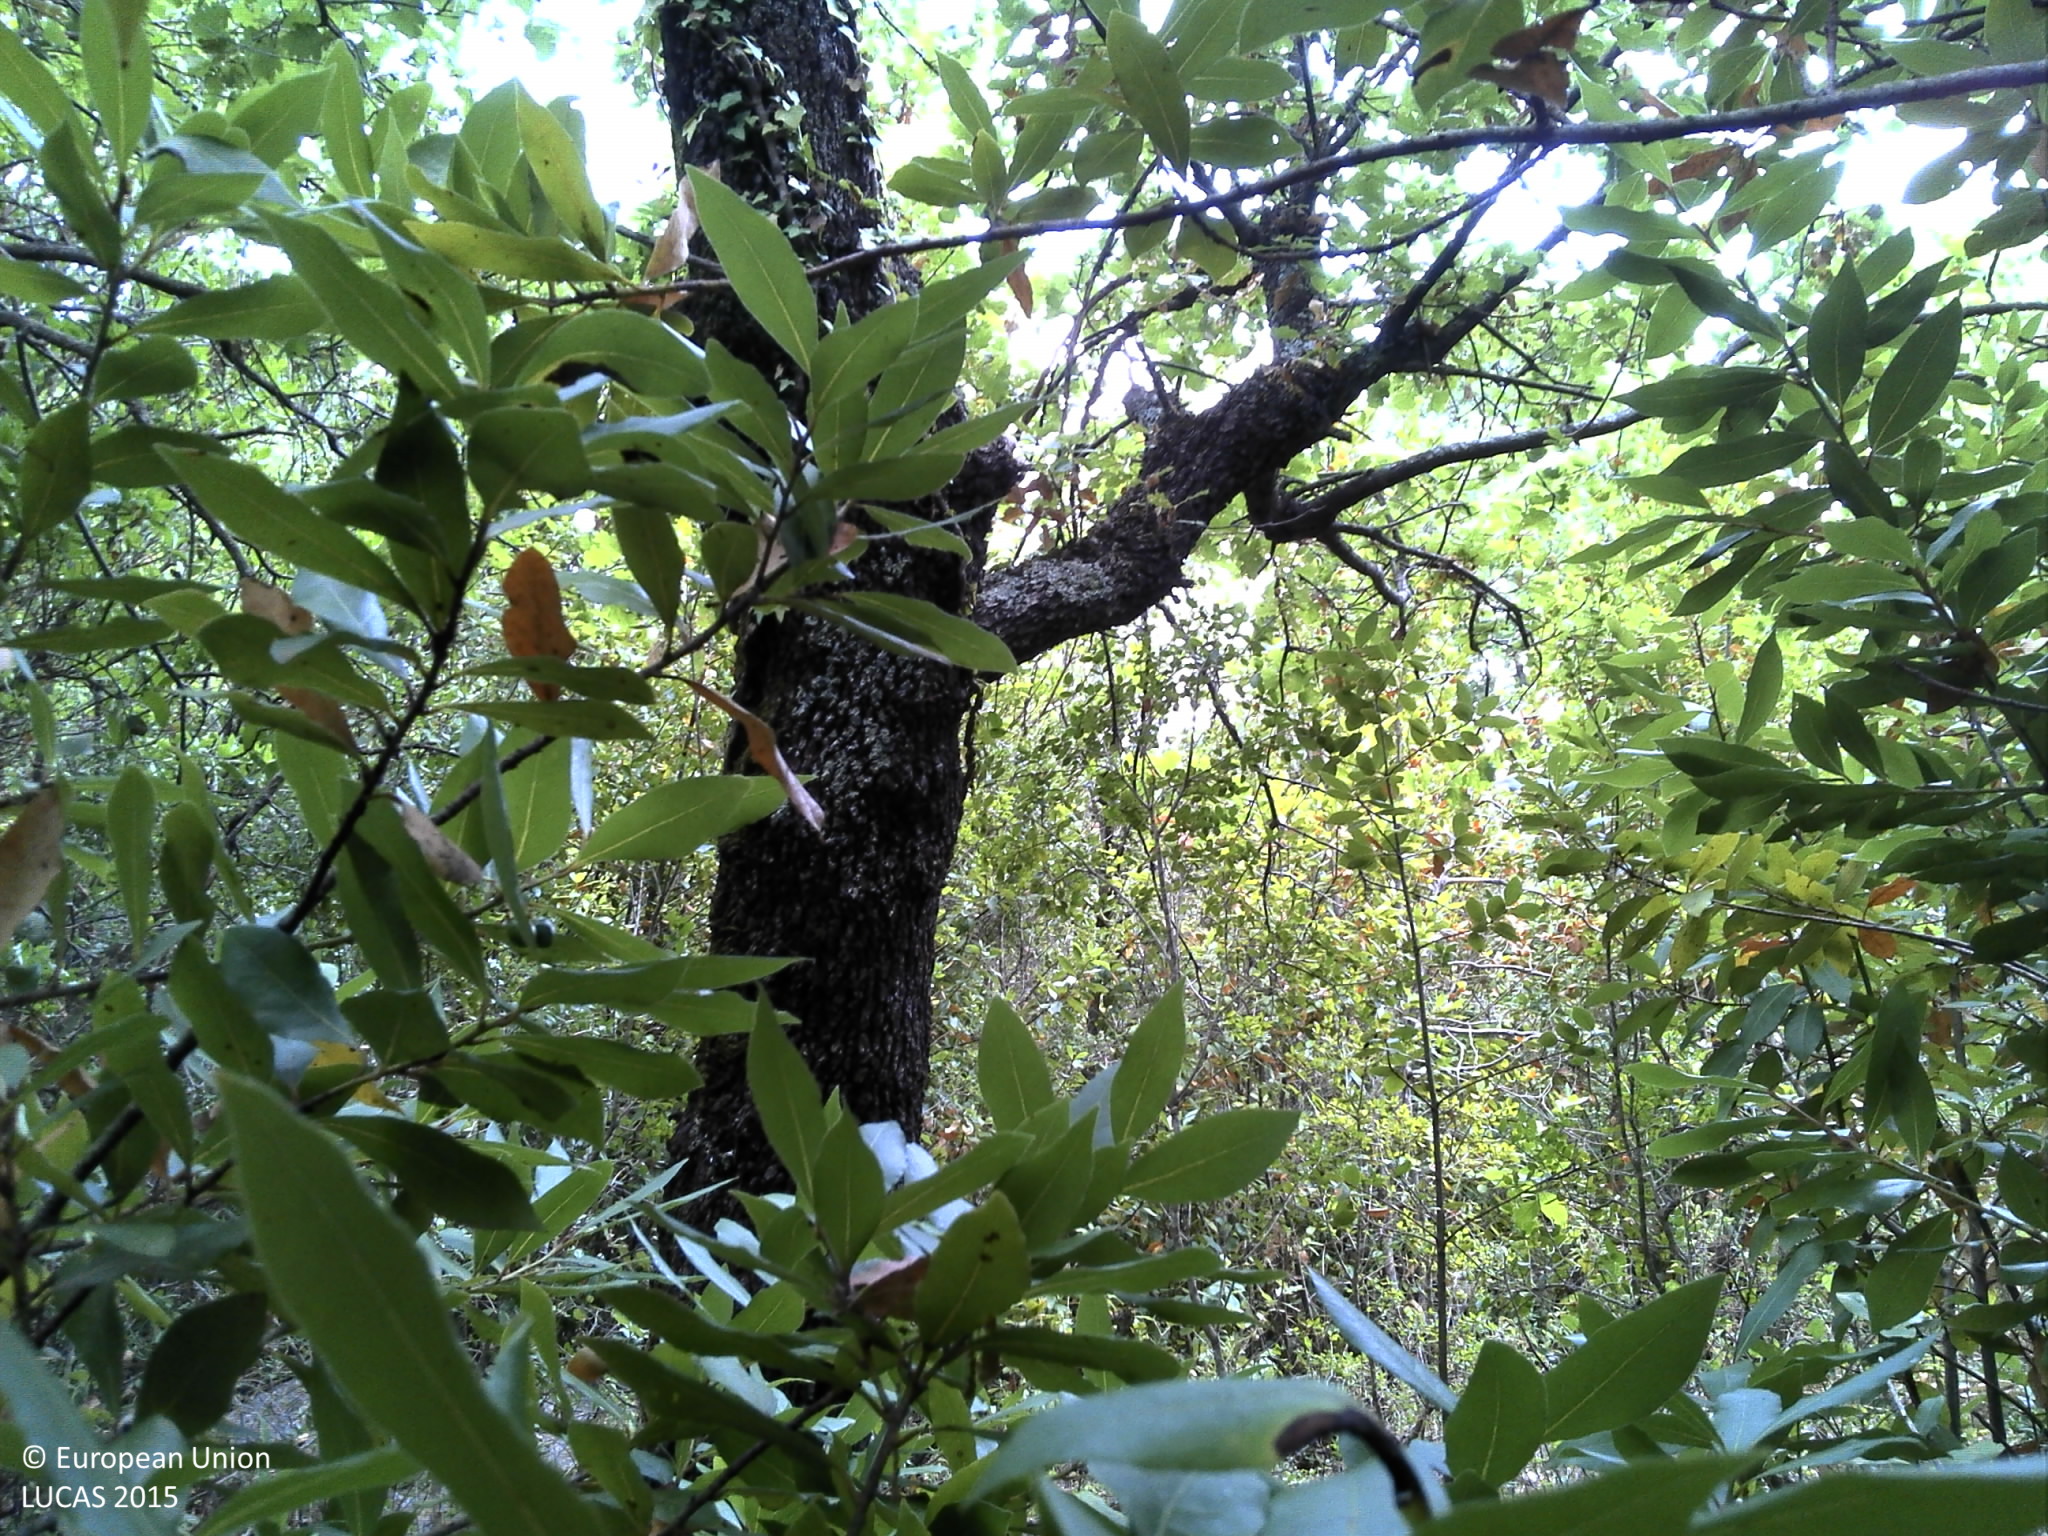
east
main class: Woodland
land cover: Other mixed woodland
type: coniferous forest of the mediterranean region
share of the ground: 25 - 50 %
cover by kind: coniferous forest trees 30 %, herbaceous plants 30 %, broadleaved forest trees 20 %, shrubs 10 %, unconsolidated bare surface 10 %
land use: Semi-natural and natural areas not in use
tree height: > 5 m
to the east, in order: Other mixed woodland; Grassland with sparse tree/shrub cover; Dry stone walls; Vineyards; Paved roads, cycling and walking lanes; Pine dominated coniferous woodland; Dry stone walls; Vineyards
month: July
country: HR
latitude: 42.7625
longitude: 17.8964
